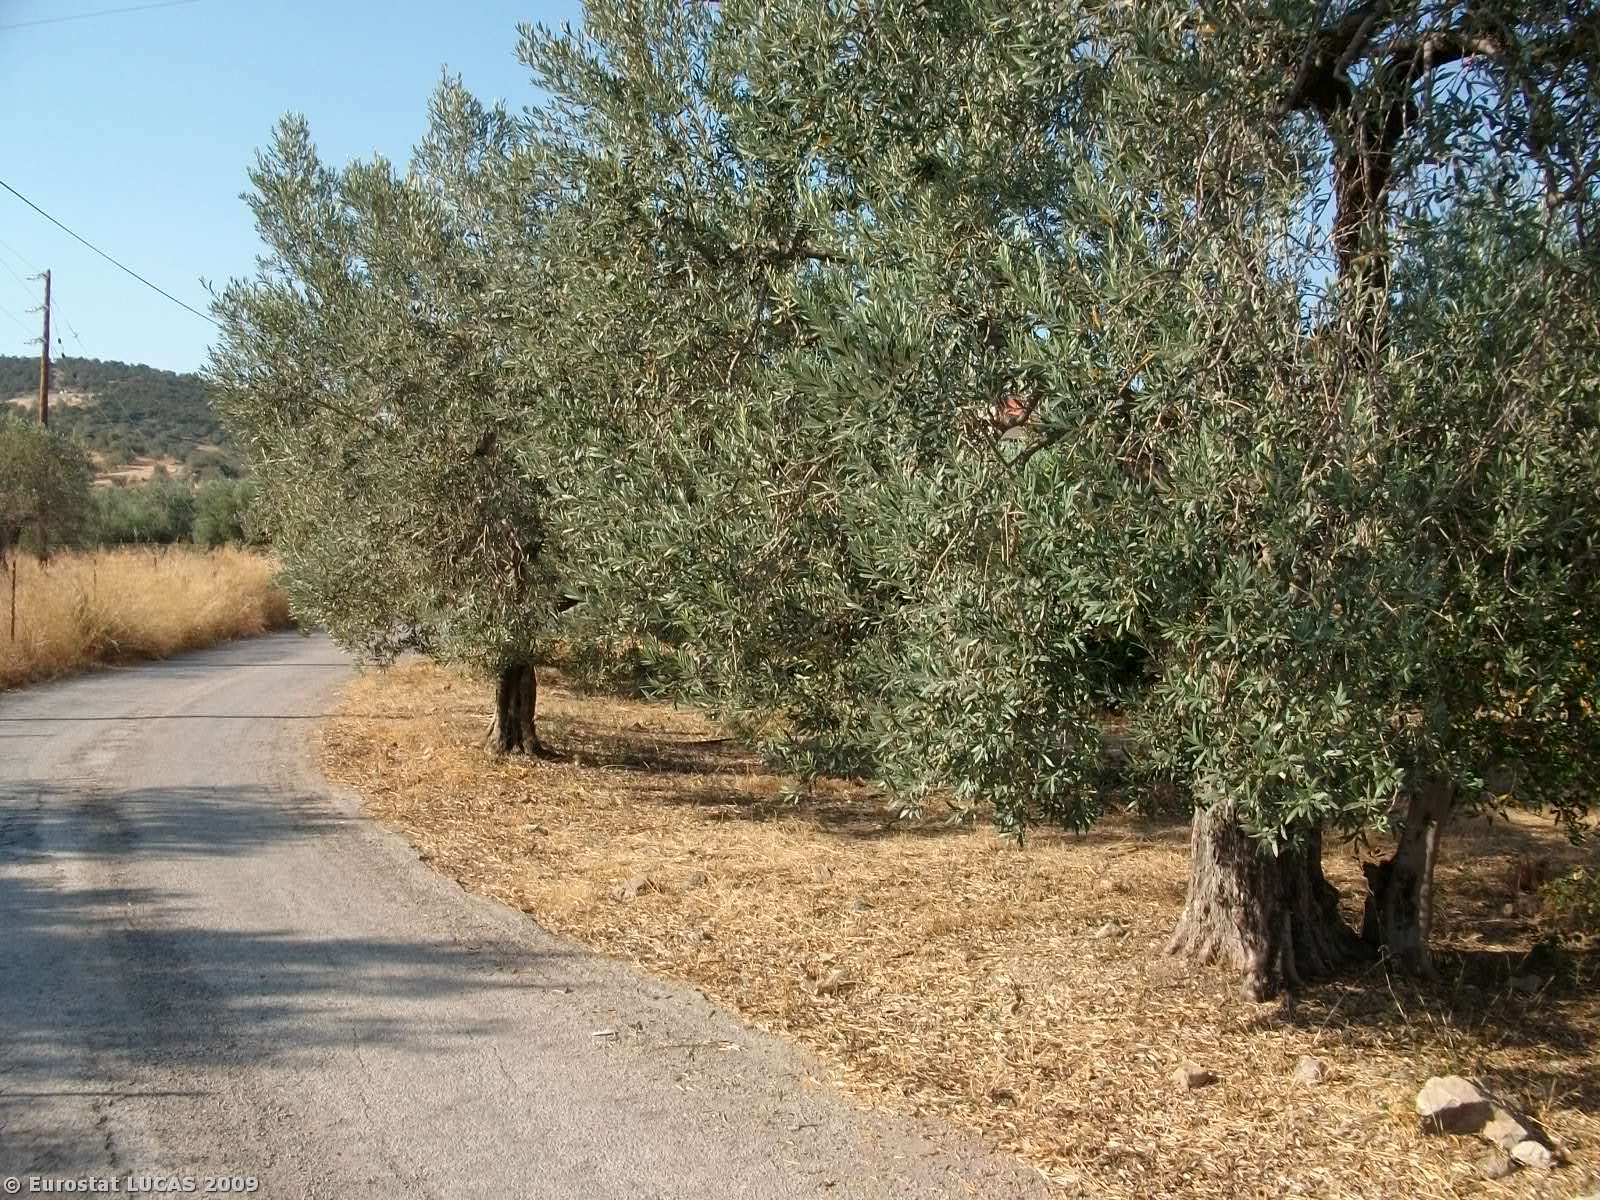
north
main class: Cropland
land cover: Olive groves
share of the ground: 25 - 50 %
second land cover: Grassland with sparse tree/shrub cover
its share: > 75 %
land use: Agriculture (excluding fallow land and kitchen gardens)
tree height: < 5 m
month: August
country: GR
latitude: 37.4128
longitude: 23.3112
